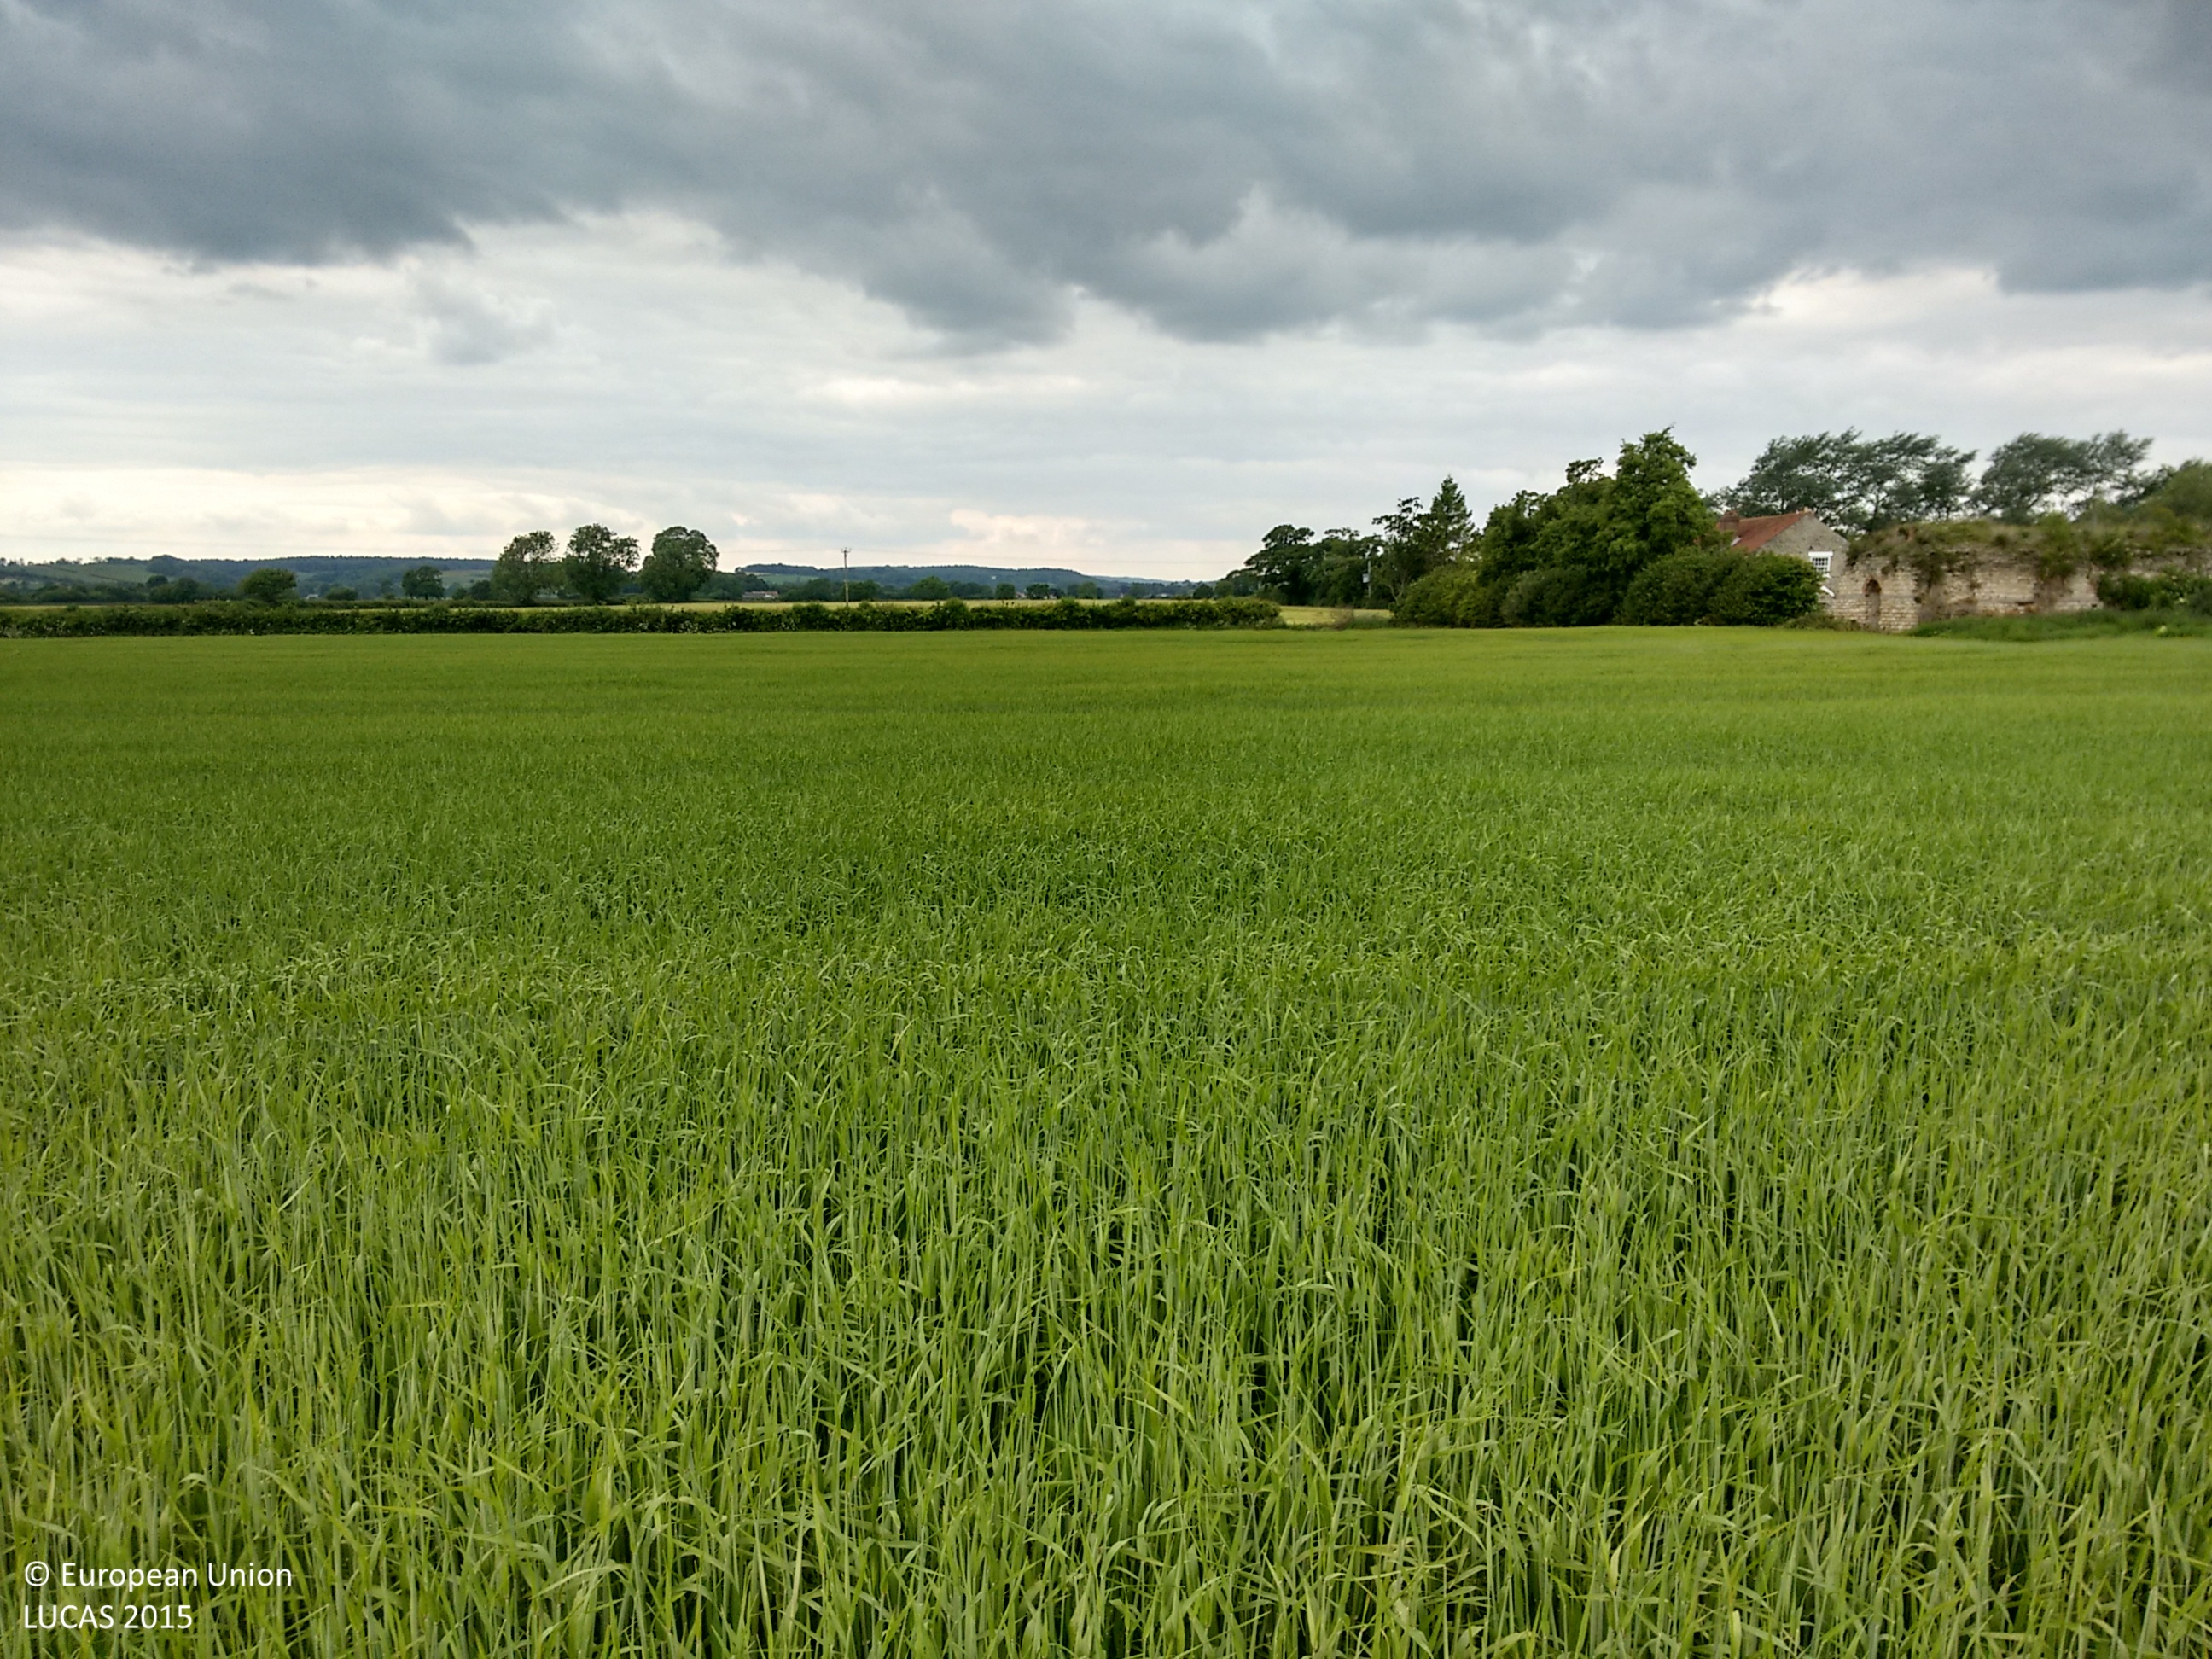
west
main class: Cropland
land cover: Barley
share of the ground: > 75 %
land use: Agriculture (excluding fallow land and kitchen gardens)
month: June
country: GB
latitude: 54.1757
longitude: -0.9342
